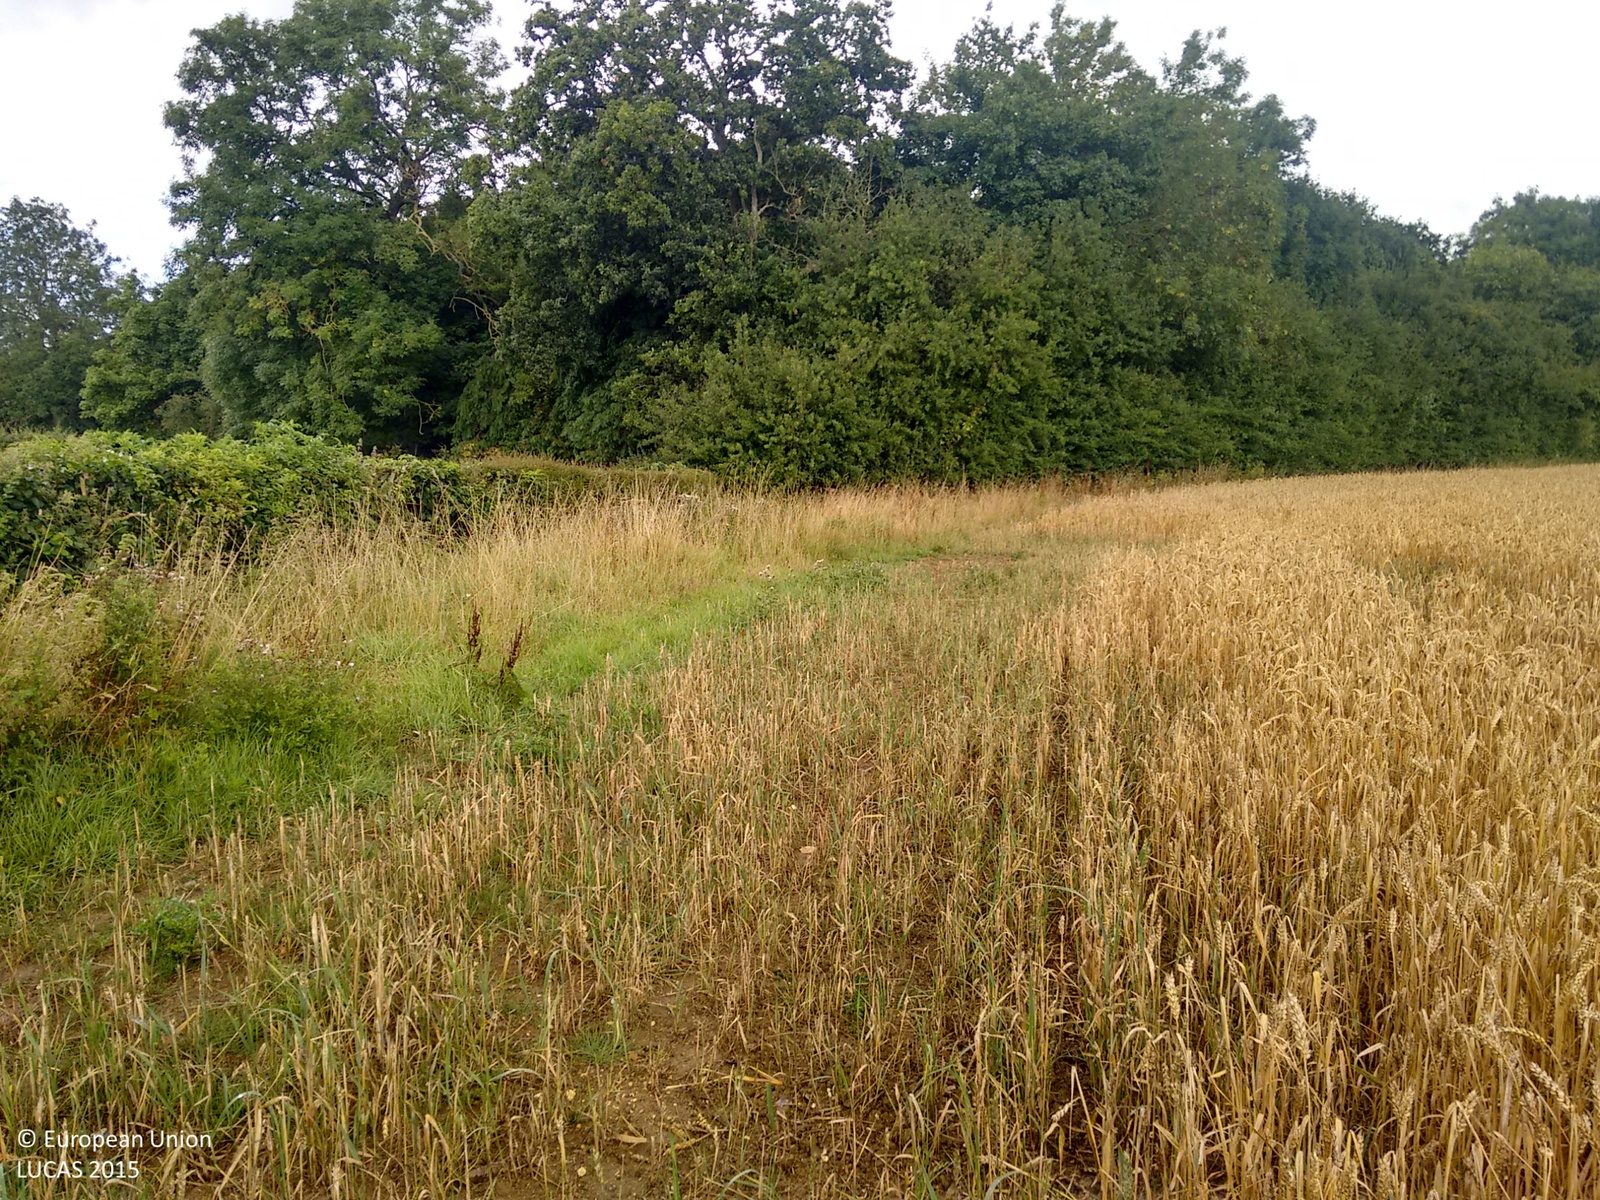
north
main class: Cropland
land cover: Common wheat
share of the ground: > 75 %
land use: Agriculture (excluding fallow land and kitchen gardens)
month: August
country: GB
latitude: 52.1884
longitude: 0.4198
